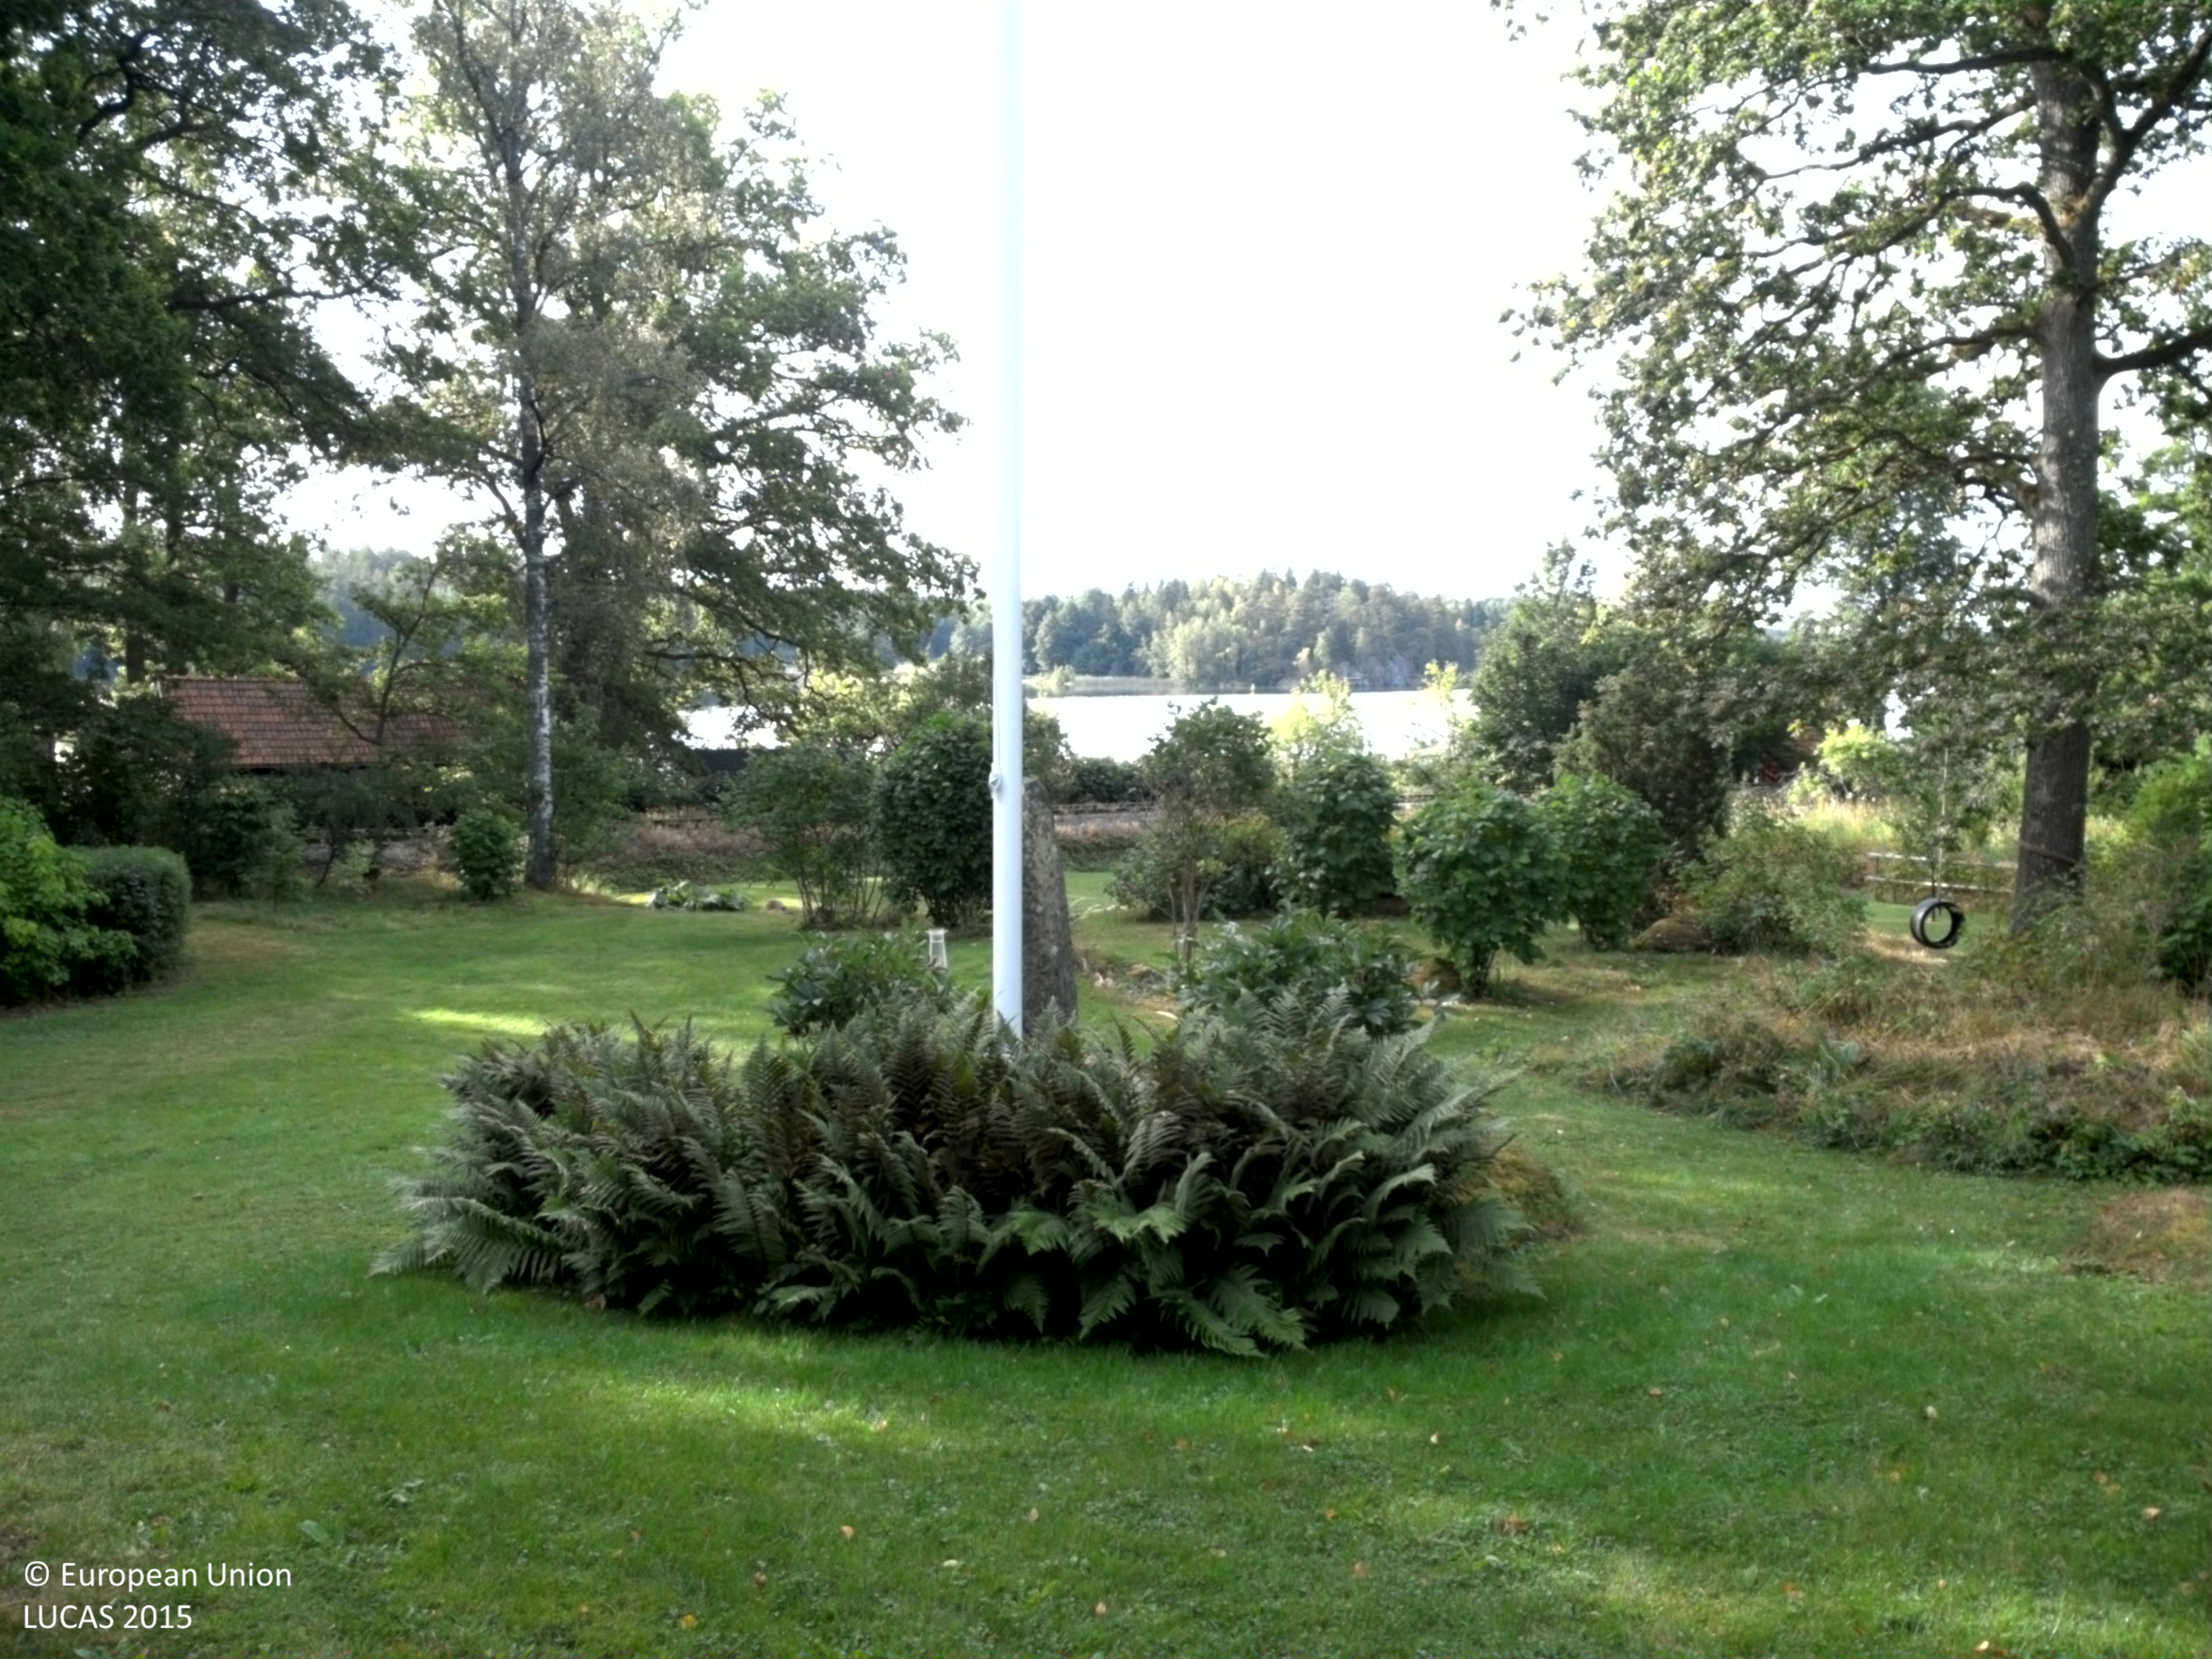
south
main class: Grassland
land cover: Grassland with sparse tree/shrub cover
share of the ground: > 75 %
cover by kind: herbaceous plants 95 %, broadleaved forest trees 5 %
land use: Residential
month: August
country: SE
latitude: 59.8661
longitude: 17.9424
